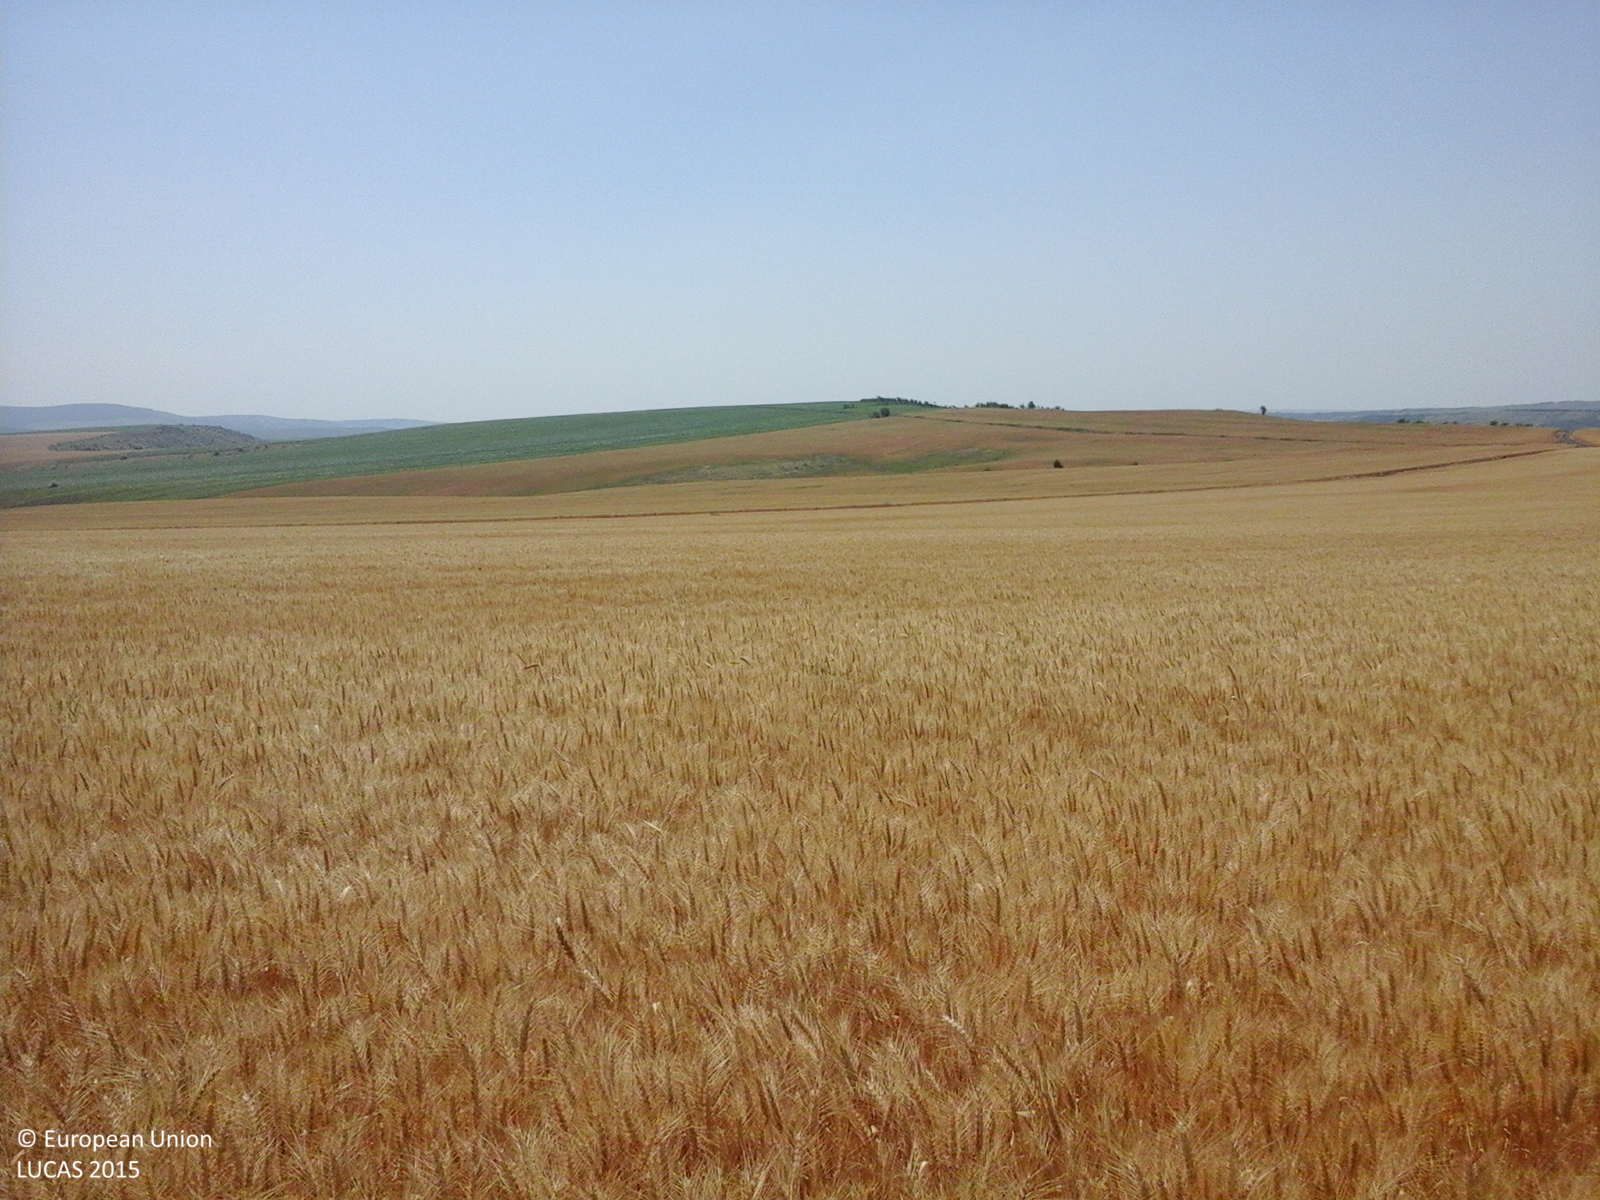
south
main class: Cropland
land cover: Common wheat
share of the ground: > 75 %
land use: Agriculture (excluding fallow land and kitchen gardens)
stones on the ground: < 10 %
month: June
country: RO
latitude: 46.6748
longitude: 27.8623
